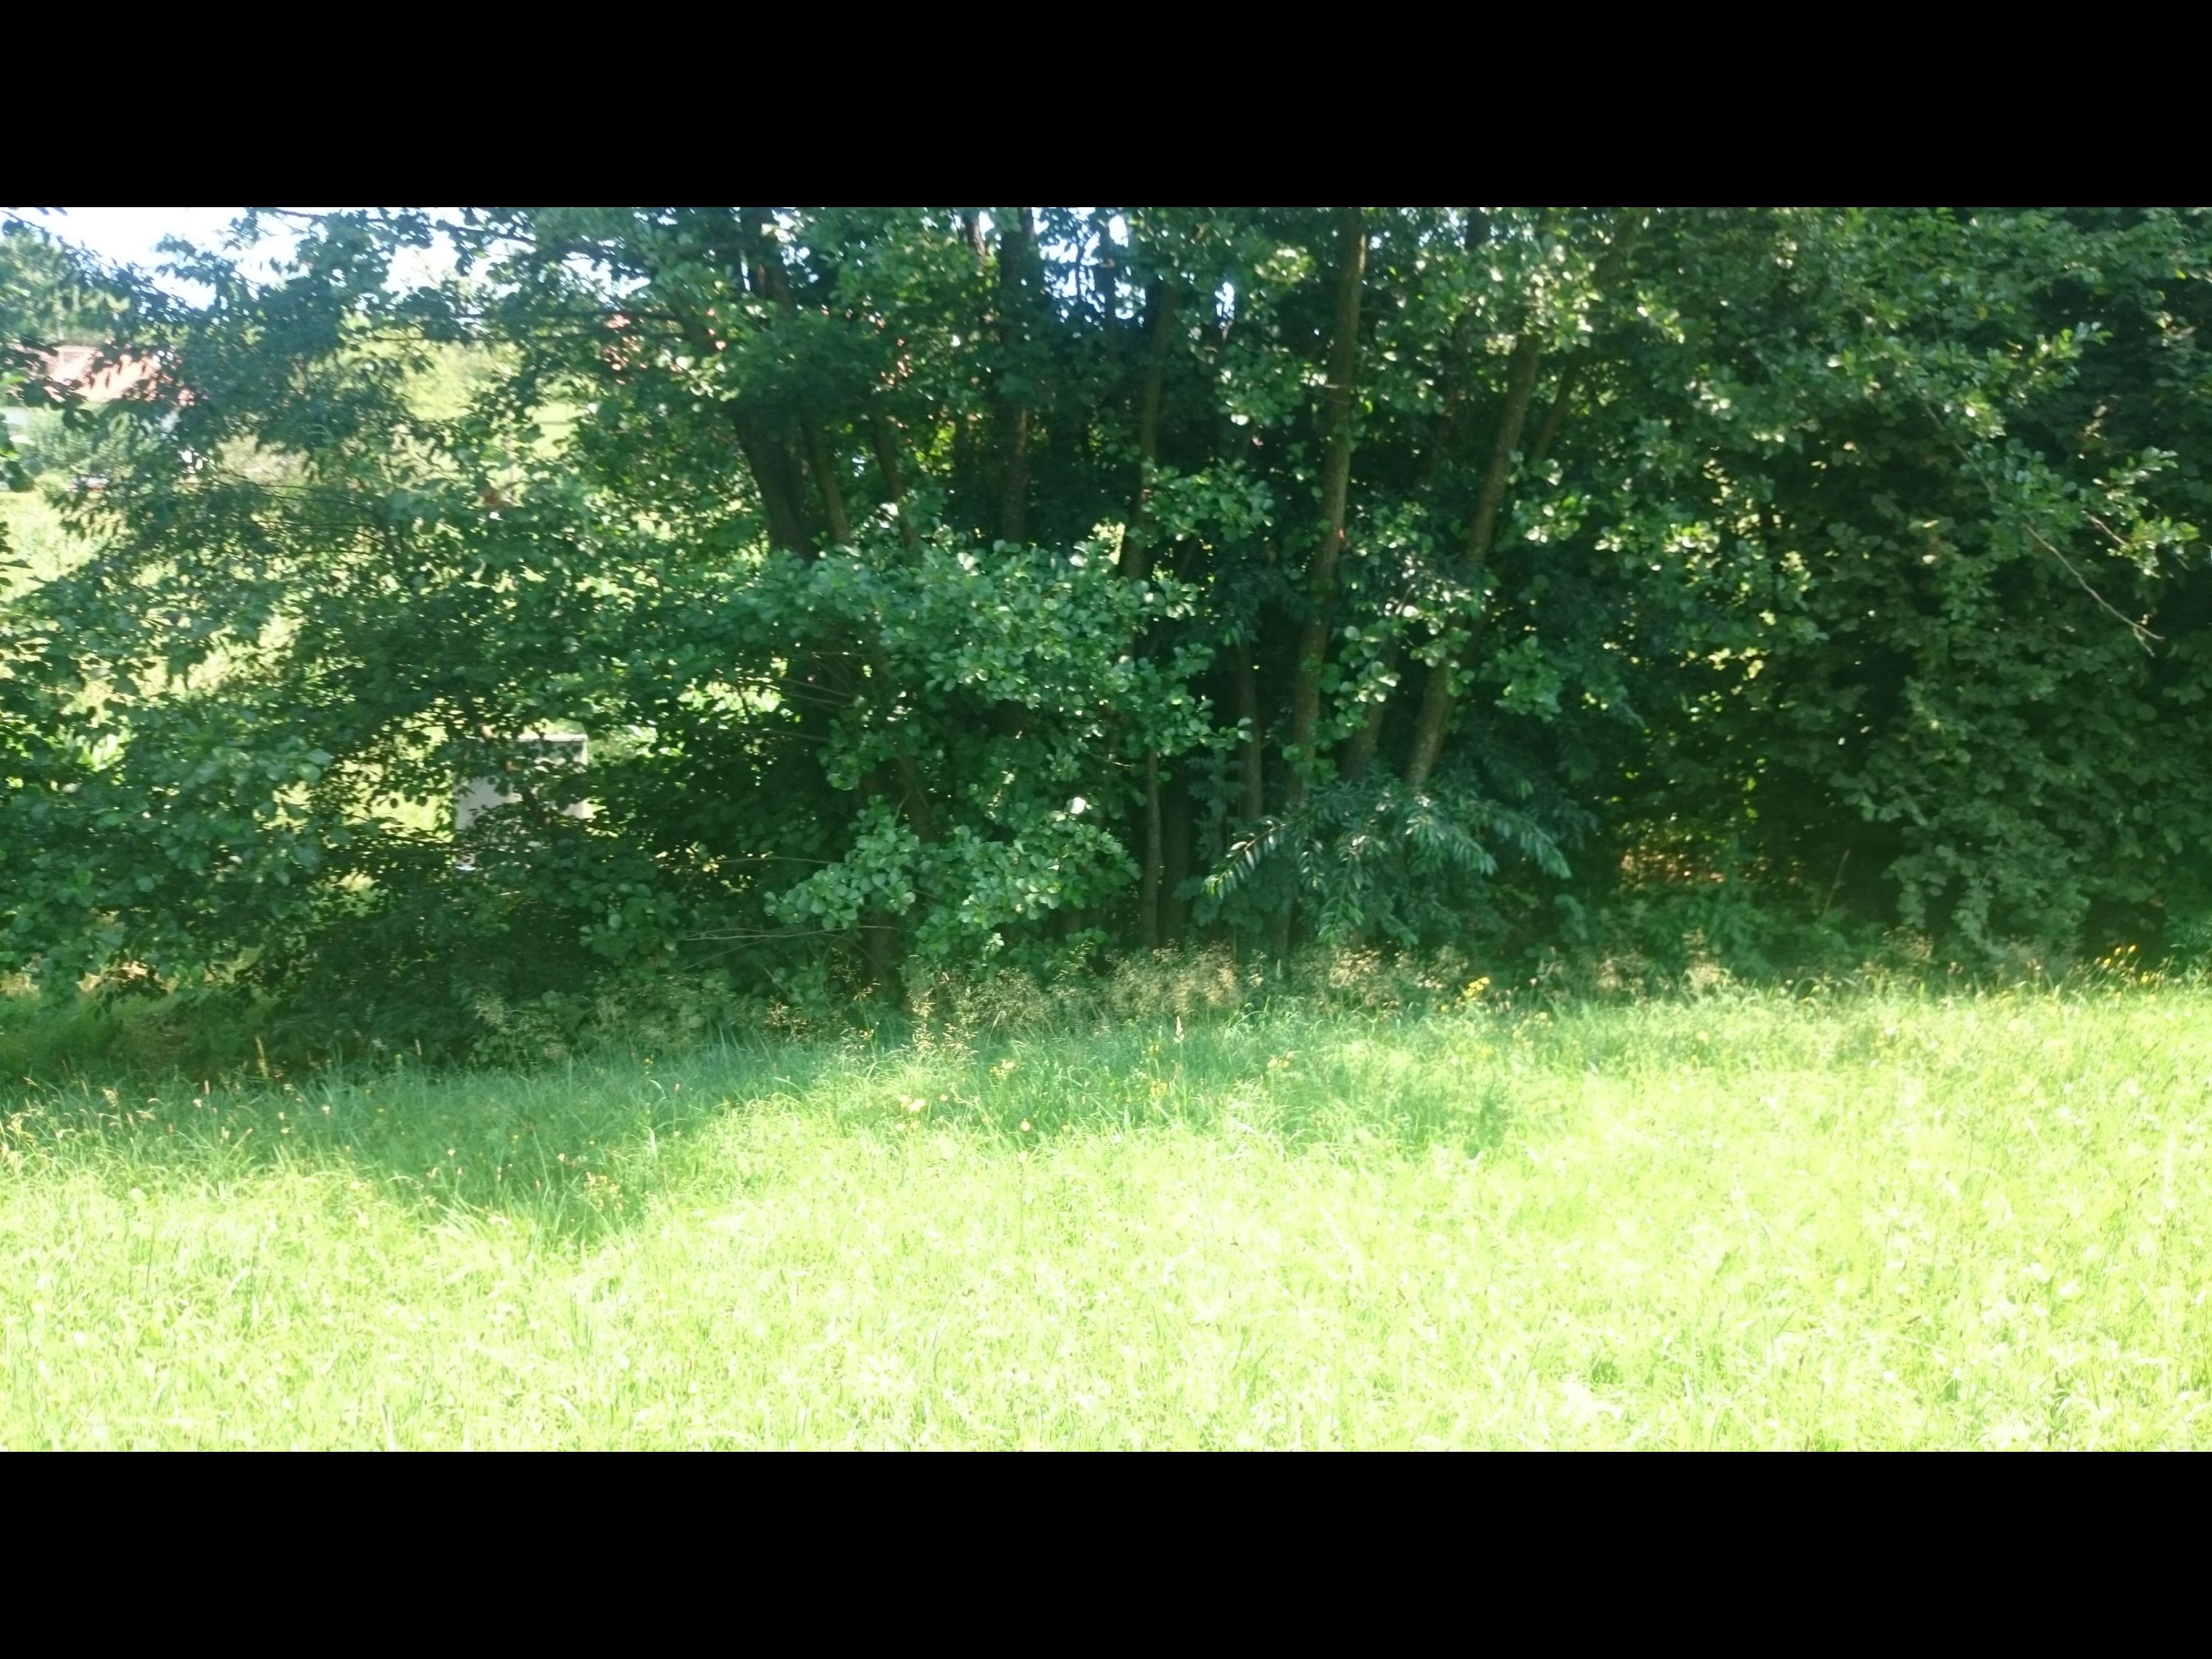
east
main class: Cropland
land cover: Maize
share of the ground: > 75 %
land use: Agriculture (excluding fallow land and kitchen gardens)
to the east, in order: Maize; Grassland without tree/shrub cover; Broadleaved woodland; Rivers and streams; Broadleaved woodland; Grass margins; Maize; Grass margins; Artificial constructions in urban areas; Cherry fruit; Fences; Vineyards; Apple fruit
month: July
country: AT
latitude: 47.0471
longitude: 16.0429
